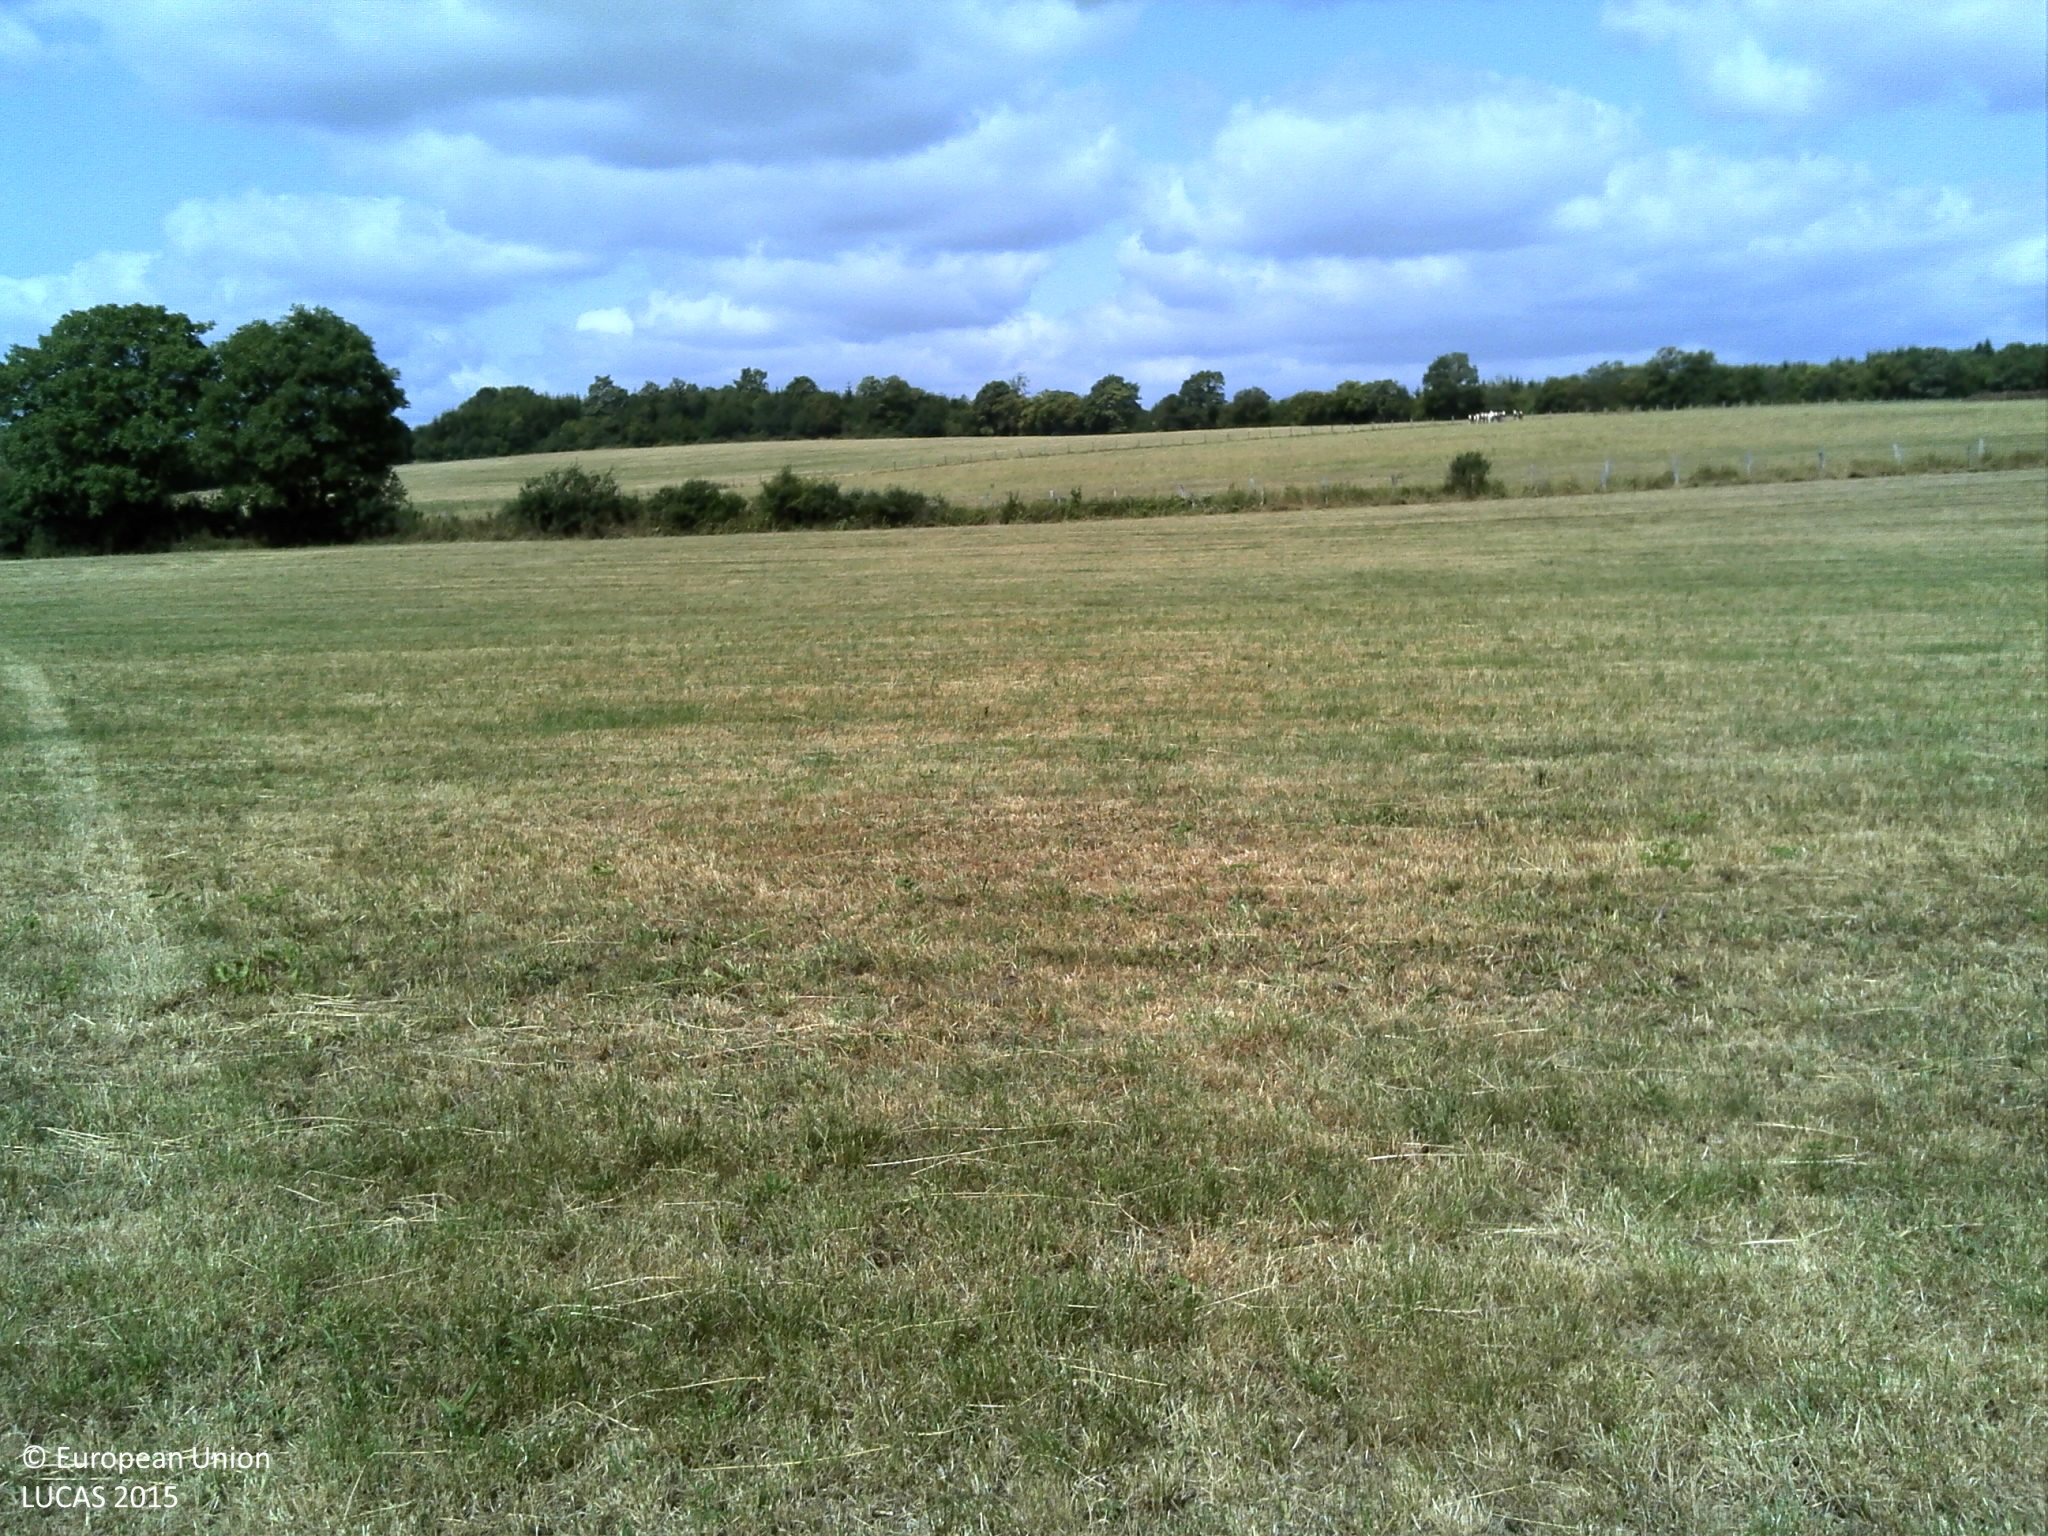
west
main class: Grassland
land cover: Grassland without tree/shrub cover
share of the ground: > 75 %
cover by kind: herbaceous plants 100 %
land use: Agriculture (excluding fallow land and kitchen gardens)
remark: Harvested field
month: July
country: FR
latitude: 48.1778
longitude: 6.2484
